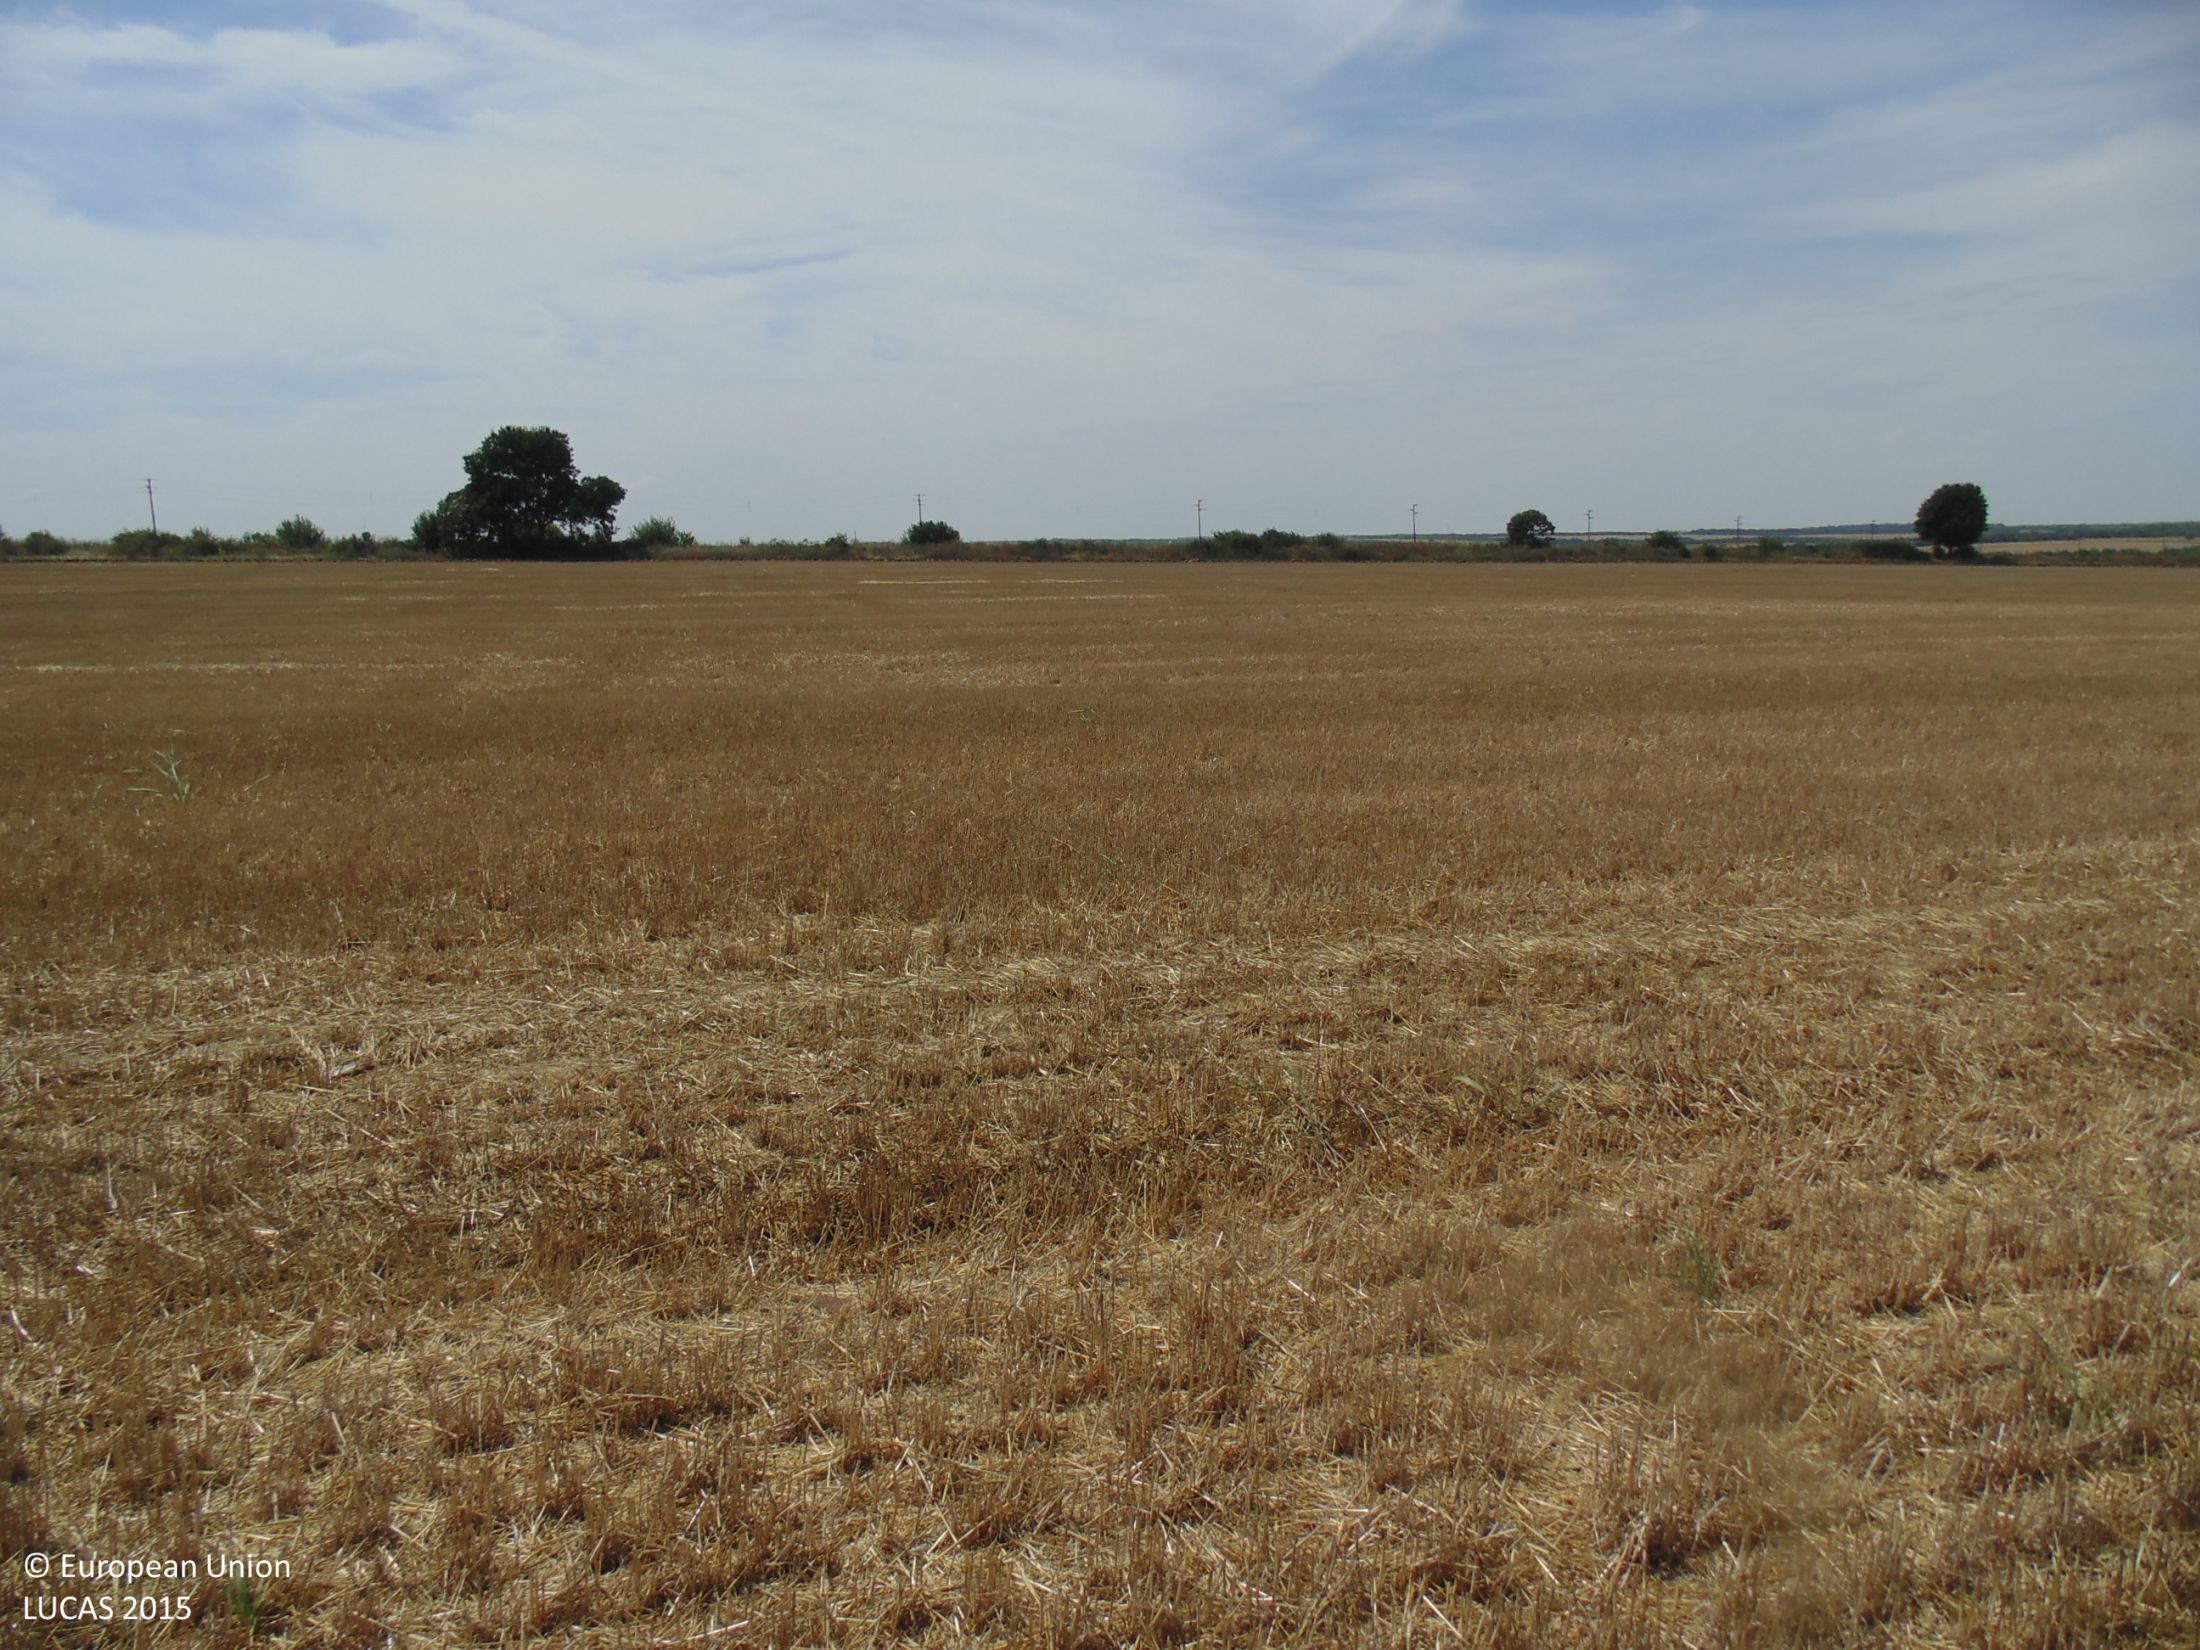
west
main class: Cropland
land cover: Common wheat
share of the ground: 25 - 50 %
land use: Agriculture (excluding fallow land and kitchen gardens)
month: August
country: BG
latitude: 43.6262
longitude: 28.5178
